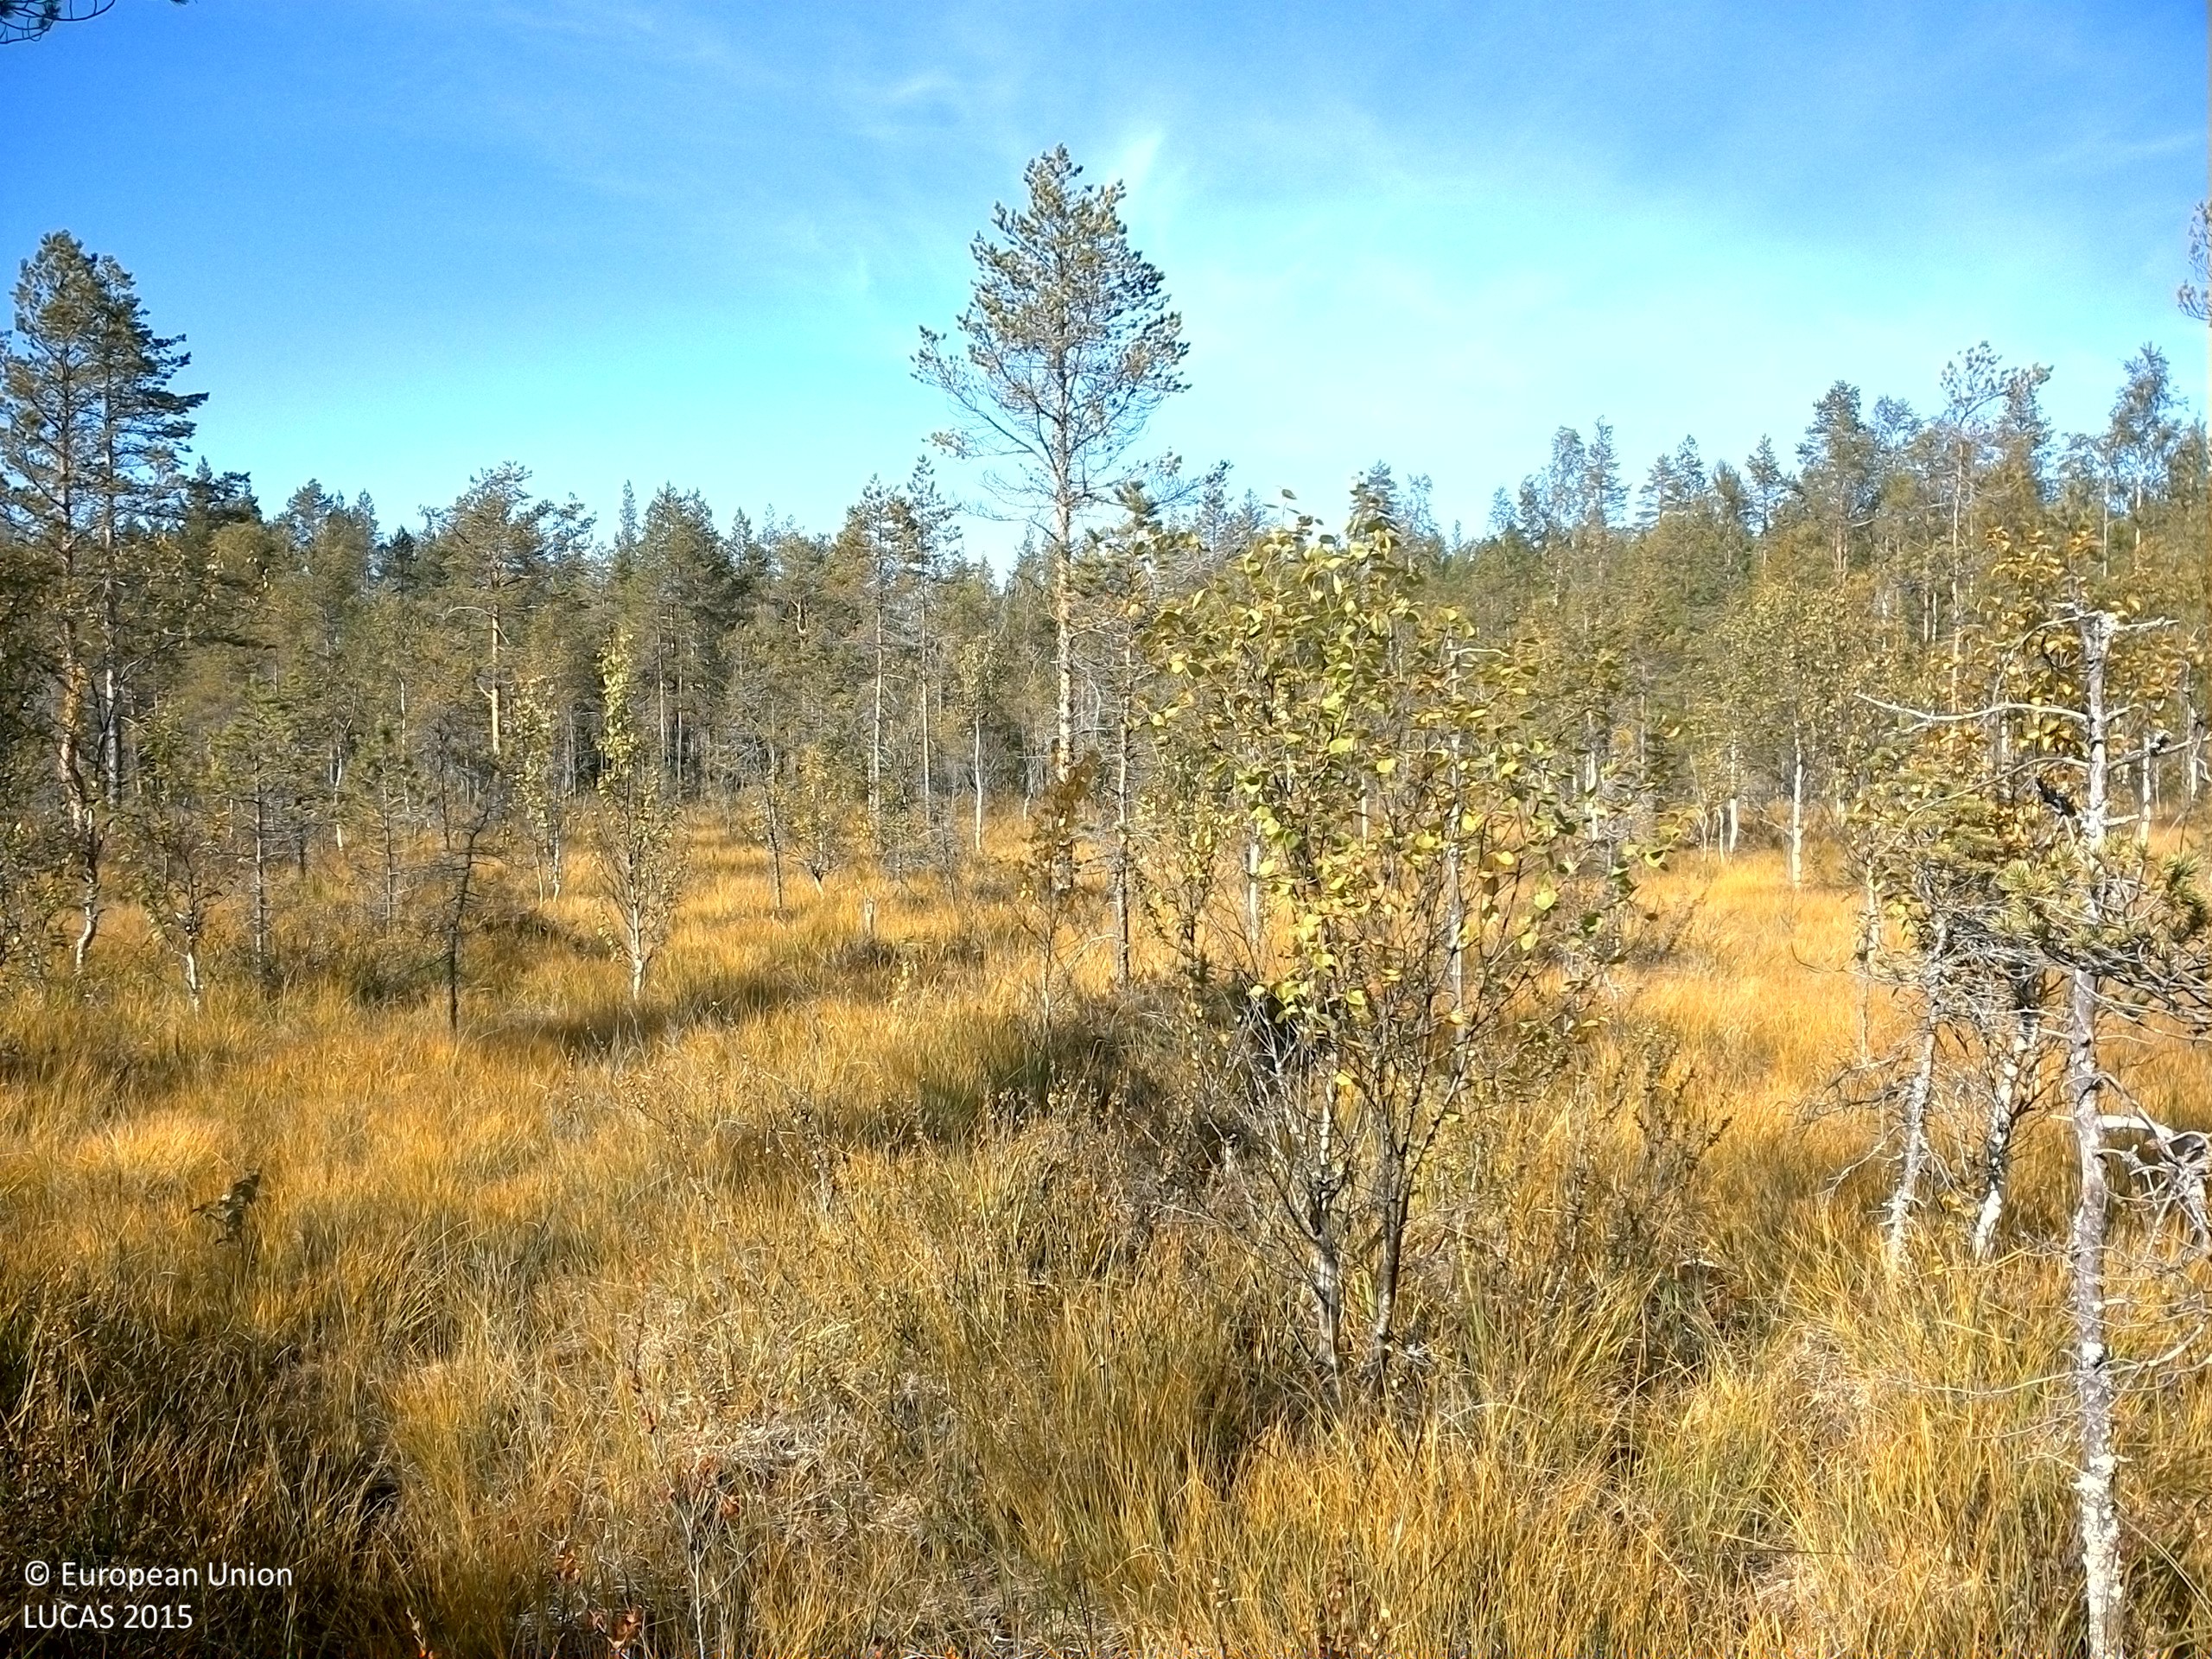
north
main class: Woodland
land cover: Pine dominated mixed woodland
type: mire and swamp forests
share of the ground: 10 - 25 %
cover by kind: herbaceous plants 45 %, shrubs 20 %, lichens and mosses 15 %, coniferous forest trees 10 %, broadleaved forest trees 10 %
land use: Semi-natural and natural areas not in use
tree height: < 5 m
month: September
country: SE
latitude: 63.8021
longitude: 16.7326
